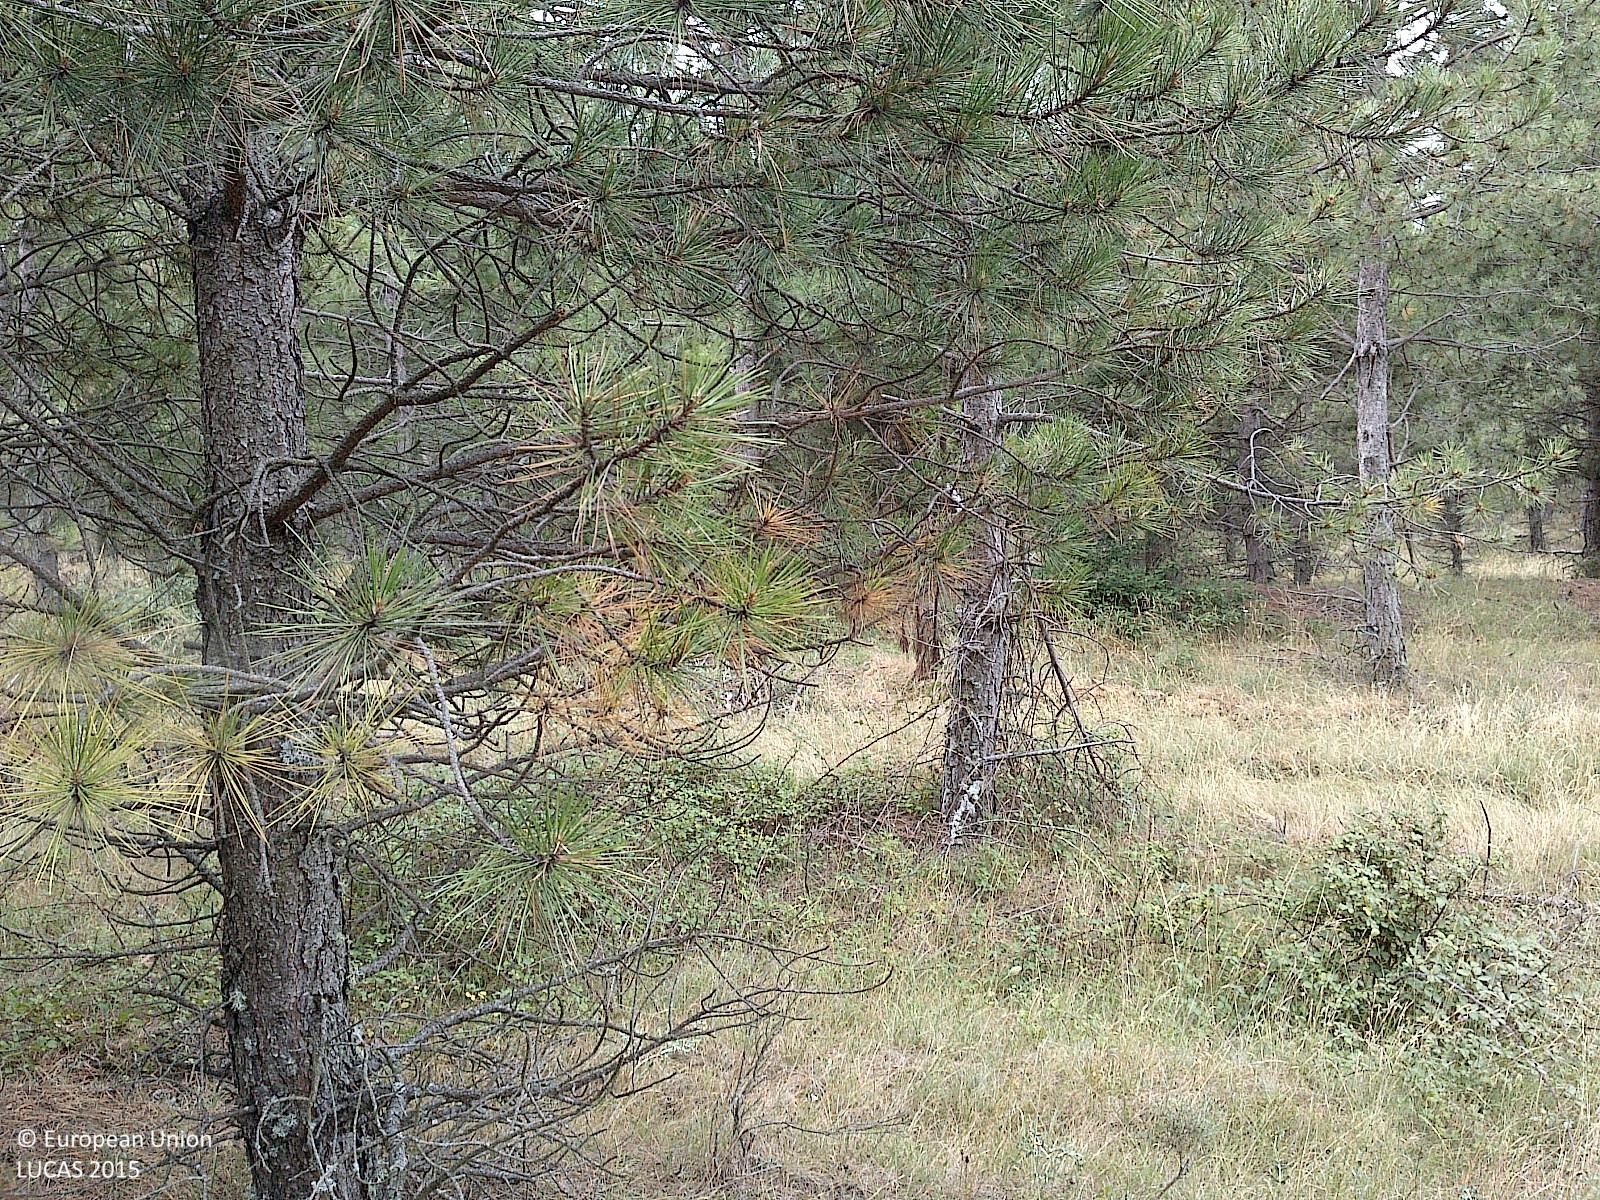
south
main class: Woodland
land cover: Pine dominated coniferous woodland
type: coniferous forest of the mediterranean region
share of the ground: 50 - 75 %
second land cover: Grassland without tree/shrub cover
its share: 50 - 75 %
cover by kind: coniferous forest trees 60 %, herbaceous plants 35 %, shrubs 5 %
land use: Forestry
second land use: Agriculture (excluding fallow land and kitchen gardens)
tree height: < 5 m
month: July
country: ES
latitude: 42.0500
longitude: -2.2781
